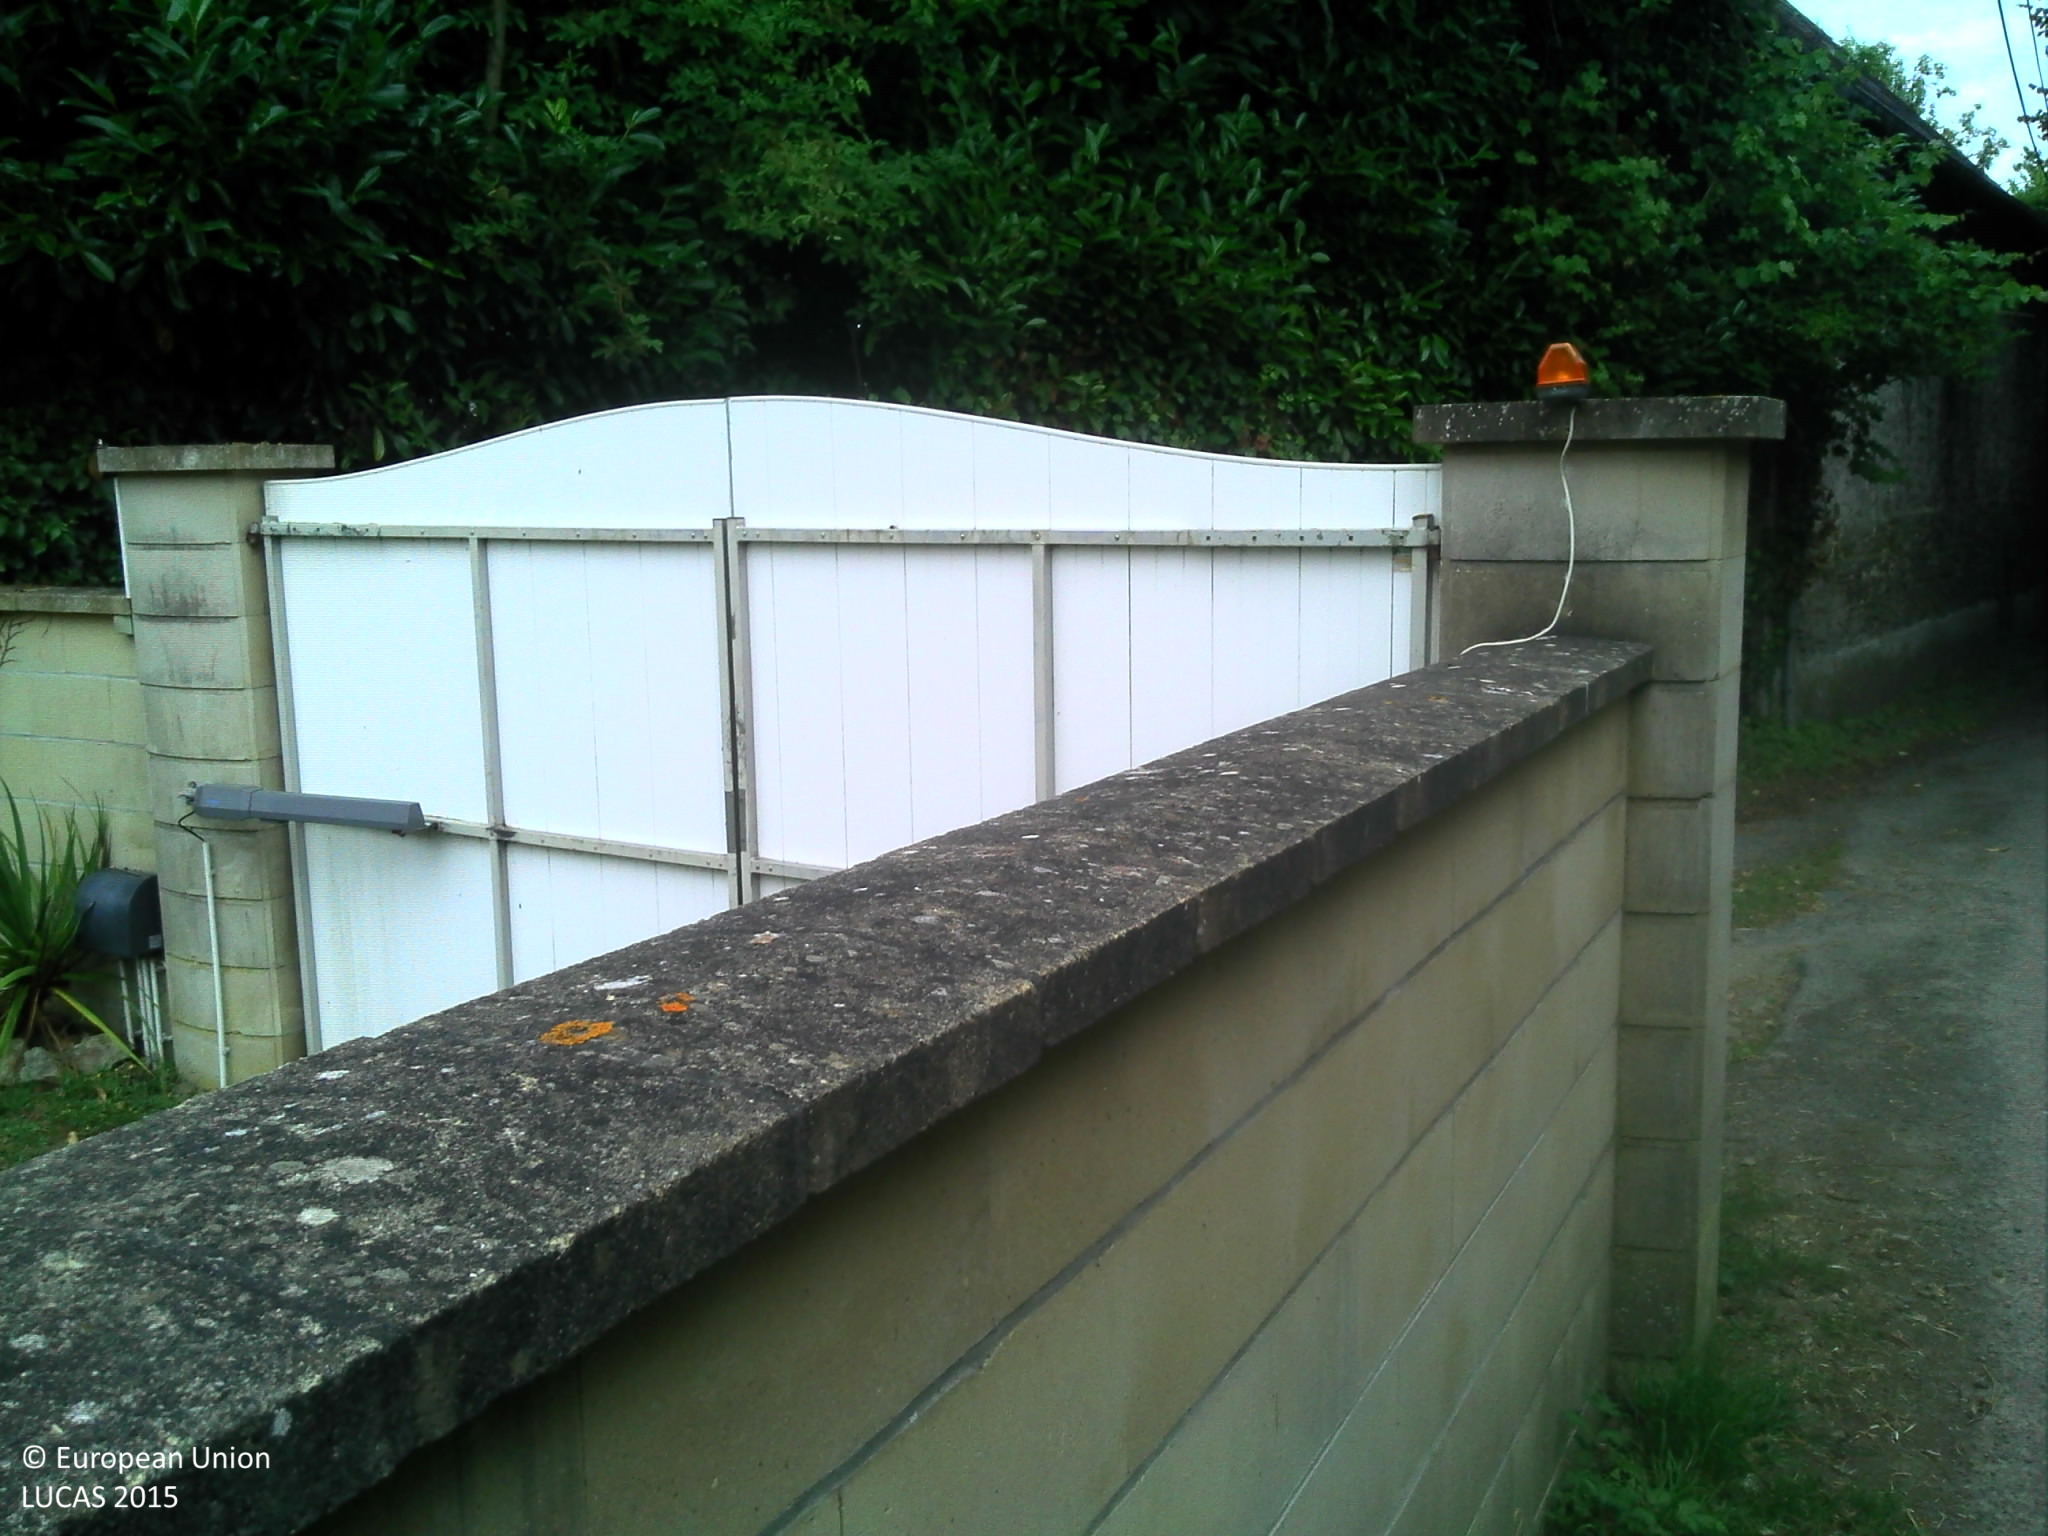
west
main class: Grassland
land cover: Grassland with sparse tree/shrub cover
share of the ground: > 75 %
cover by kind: herbaceous plants 95 %, broadleaved forest trees 5 %
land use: Residential
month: July
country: FR
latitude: 48.8513
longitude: -1.5372
